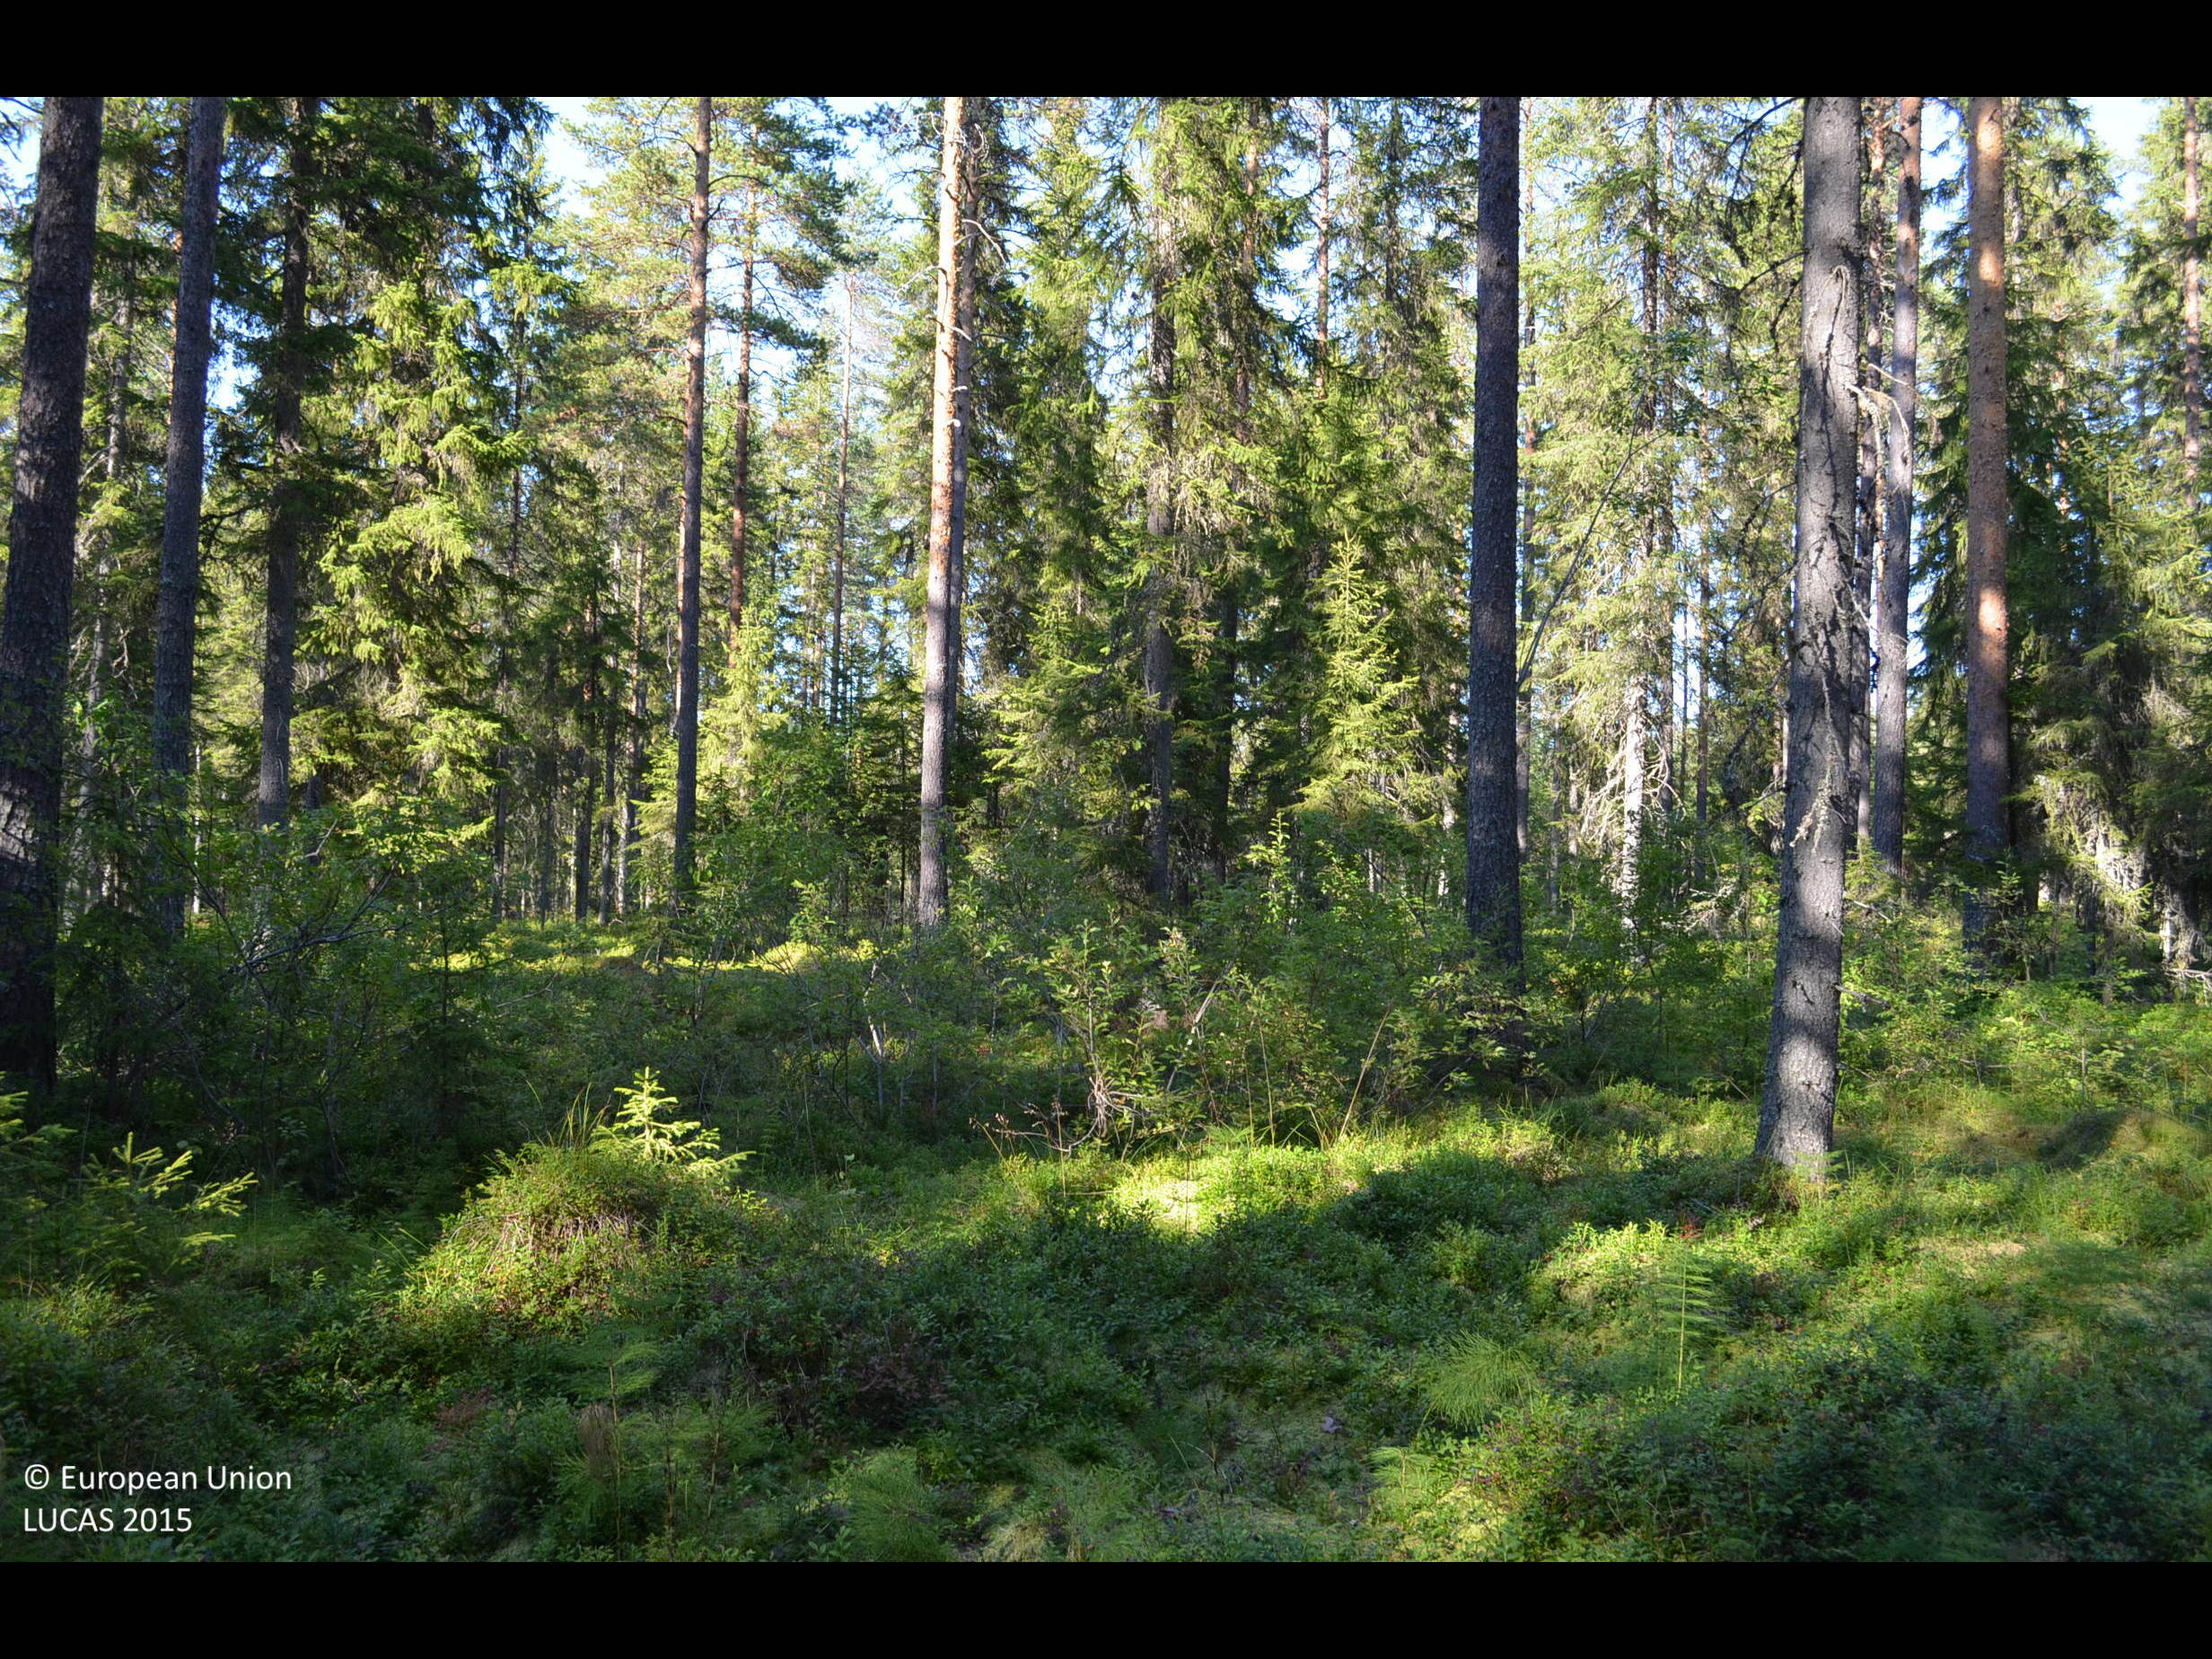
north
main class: Woodland
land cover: Other coniferous woodland
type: boreal forest
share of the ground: 50 - 75 %
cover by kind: coniferous forest trees 65 %, shrubs 20 %, lichens and mosses 10 %, broadleaved forest trees 5 %
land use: Forestry
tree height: > 5 m
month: August
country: FI
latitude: 62.5463
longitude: 24.3375
